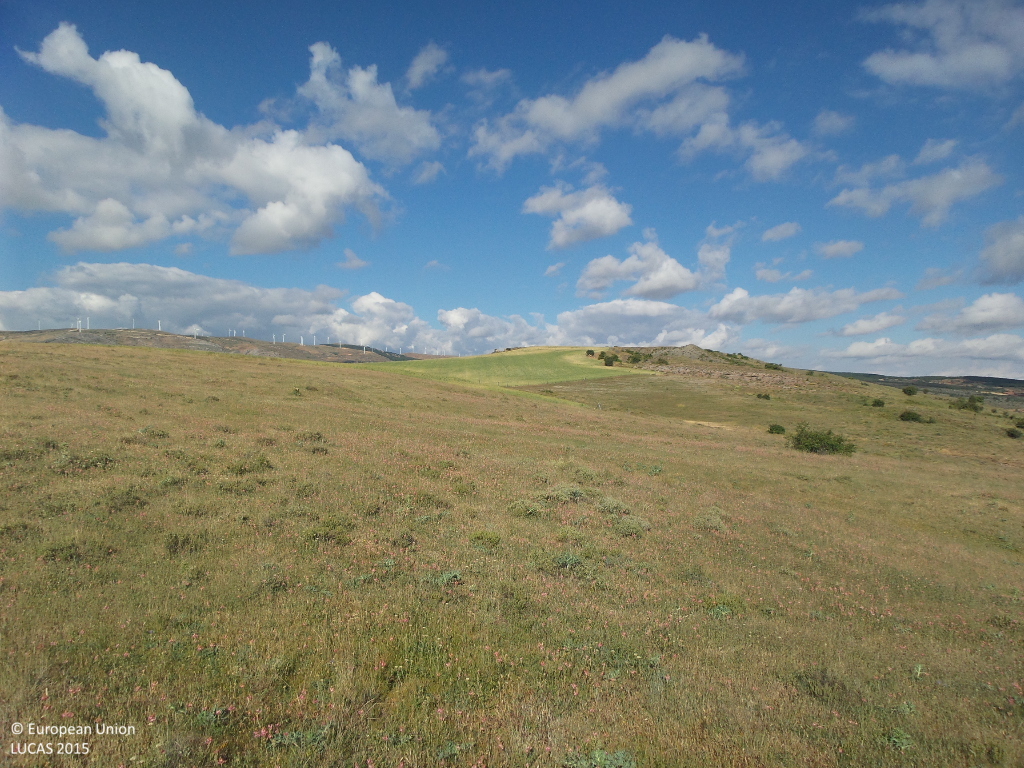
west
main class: Grassland
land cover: Grassland without tree/shrub cover
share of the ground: > 75 %
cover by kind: herbaceous plants 80 %, unconsolidated bare surface 15 %, shrubs 5 %
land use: Abandoned areas
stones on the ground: < 10 %
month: June
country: ES
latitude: 41.3094
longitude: -3.0717
